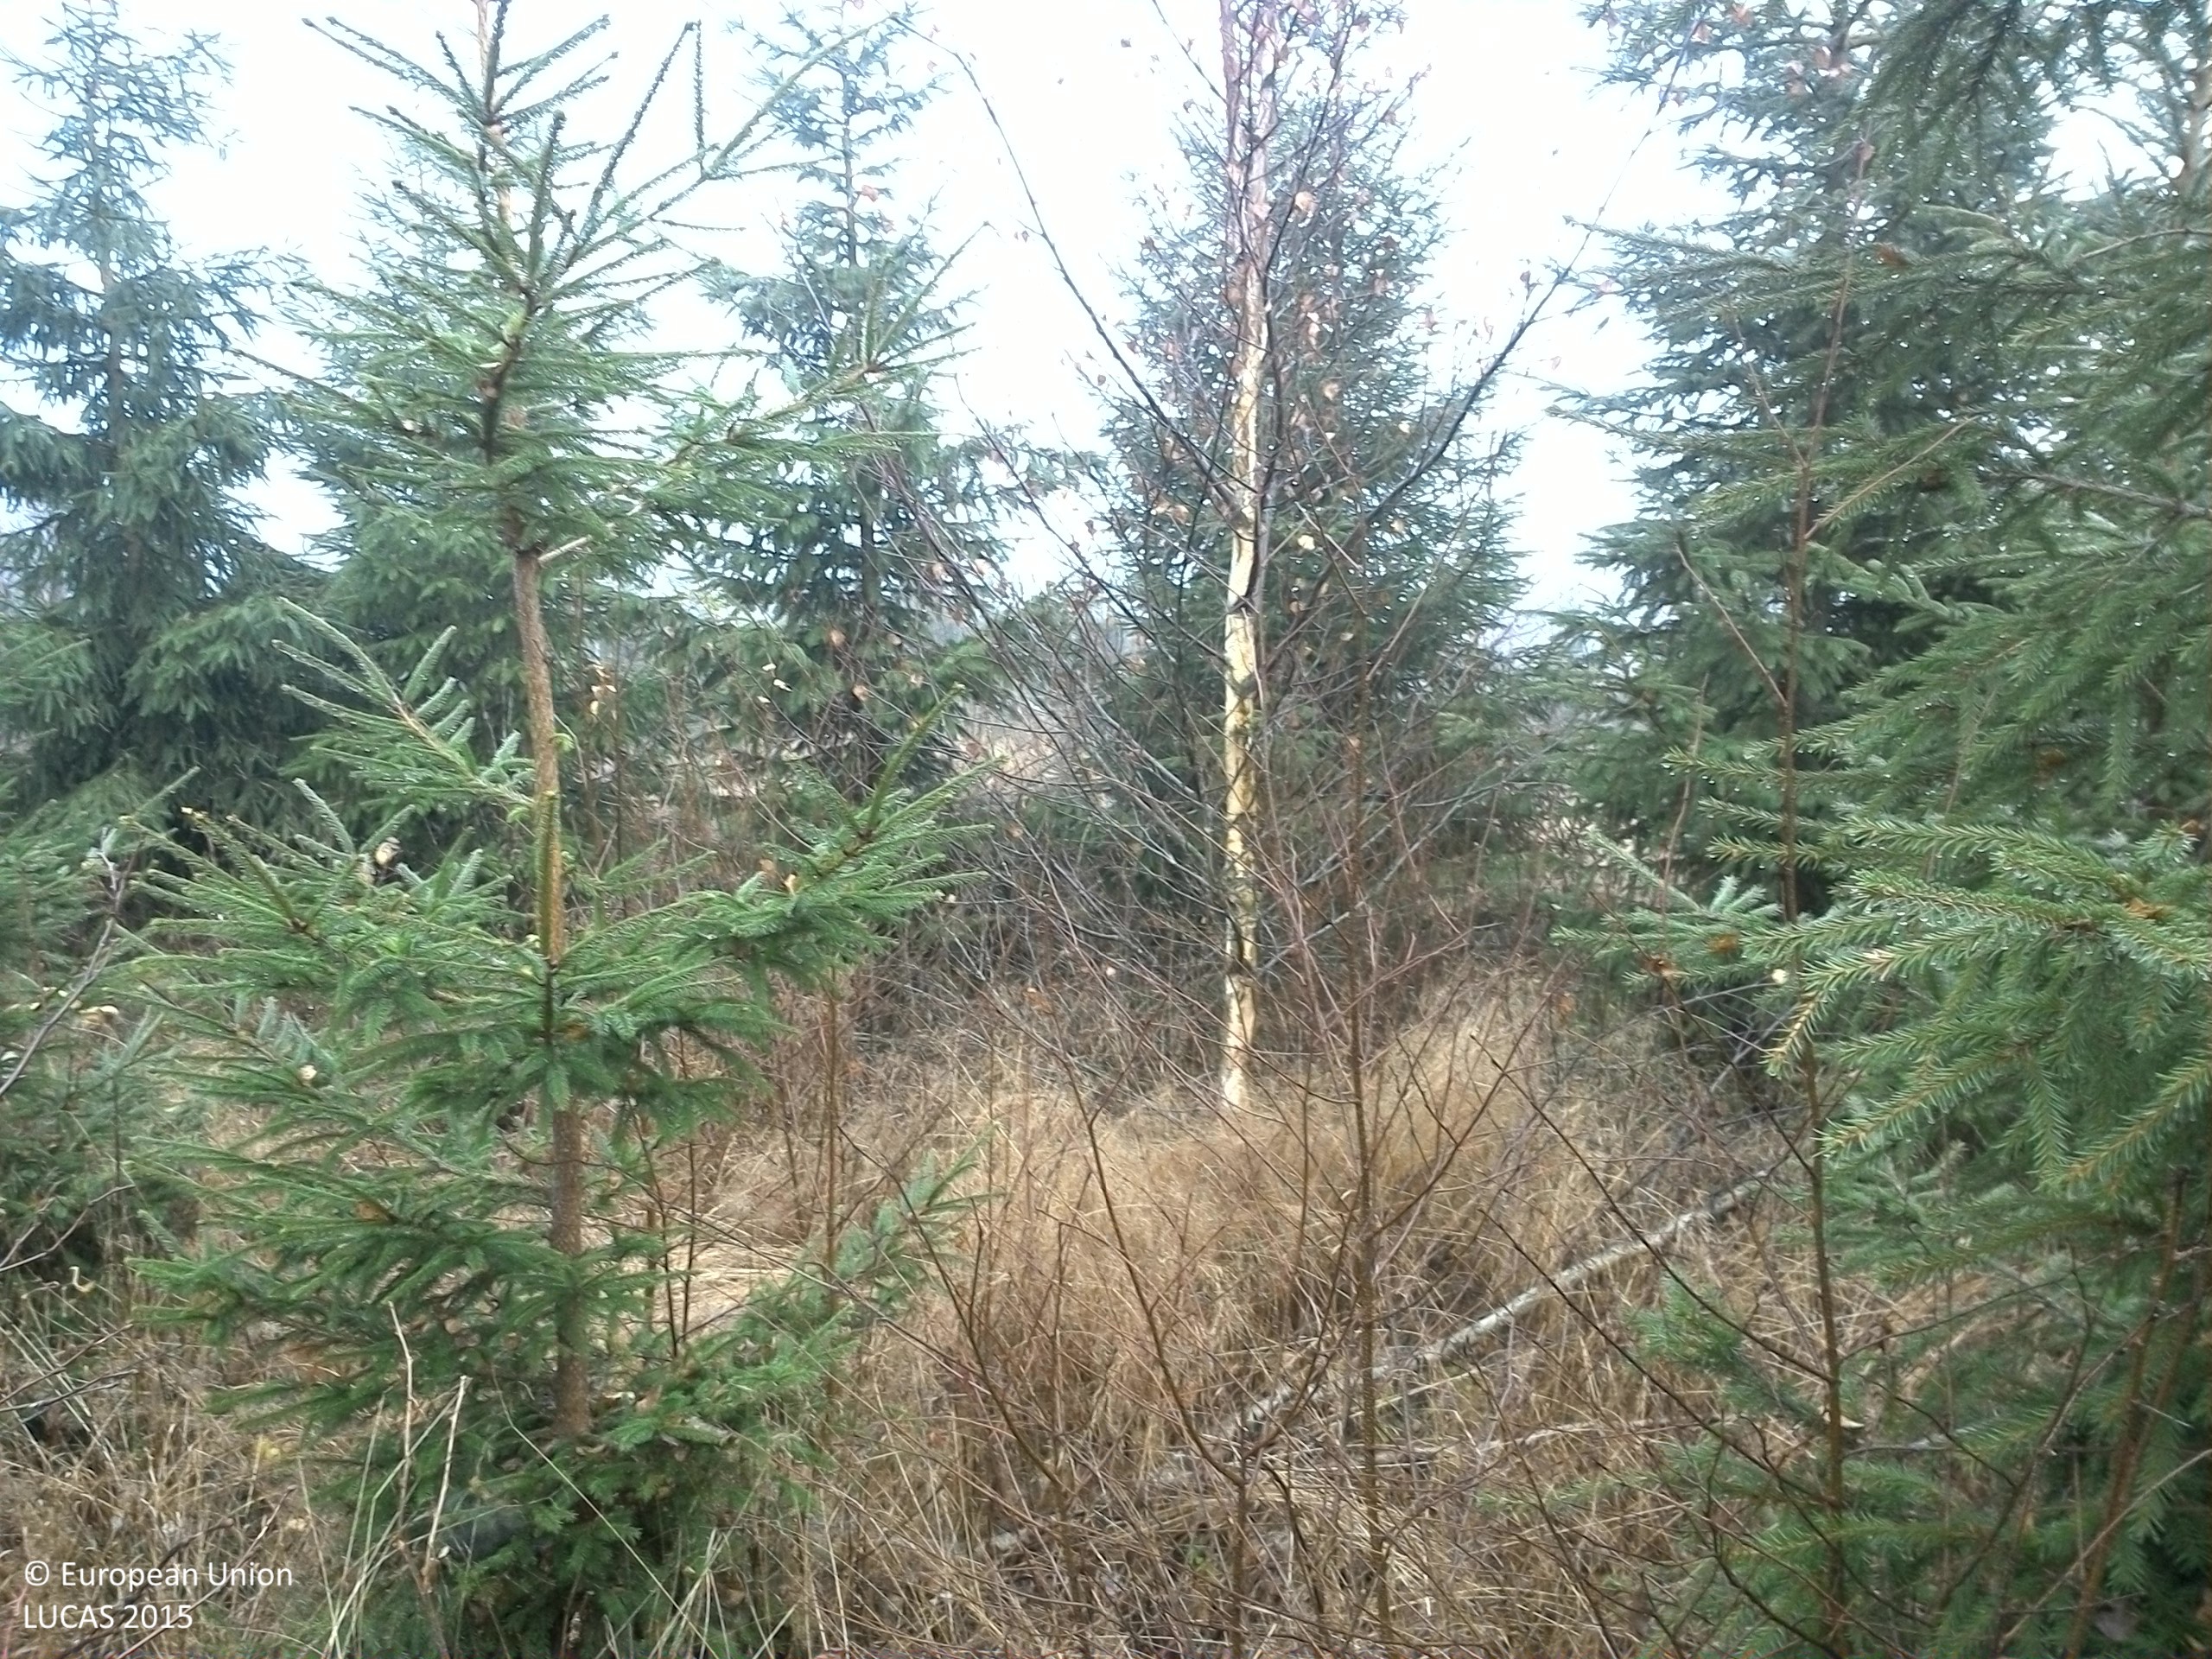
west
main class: Woodland
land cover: Spruce dominated mixed woodland
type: boreal forest
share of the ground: 50 - 75 %
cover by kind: coniferous forest trees 45 %, broadleaved forest trees 25 %, shrubs 15 %, herbaceous plants 15 %
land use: Forestry
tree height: < 5 m
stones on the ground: < 10 %
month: November
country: SE
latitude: 57.9150
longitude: 14.8731
